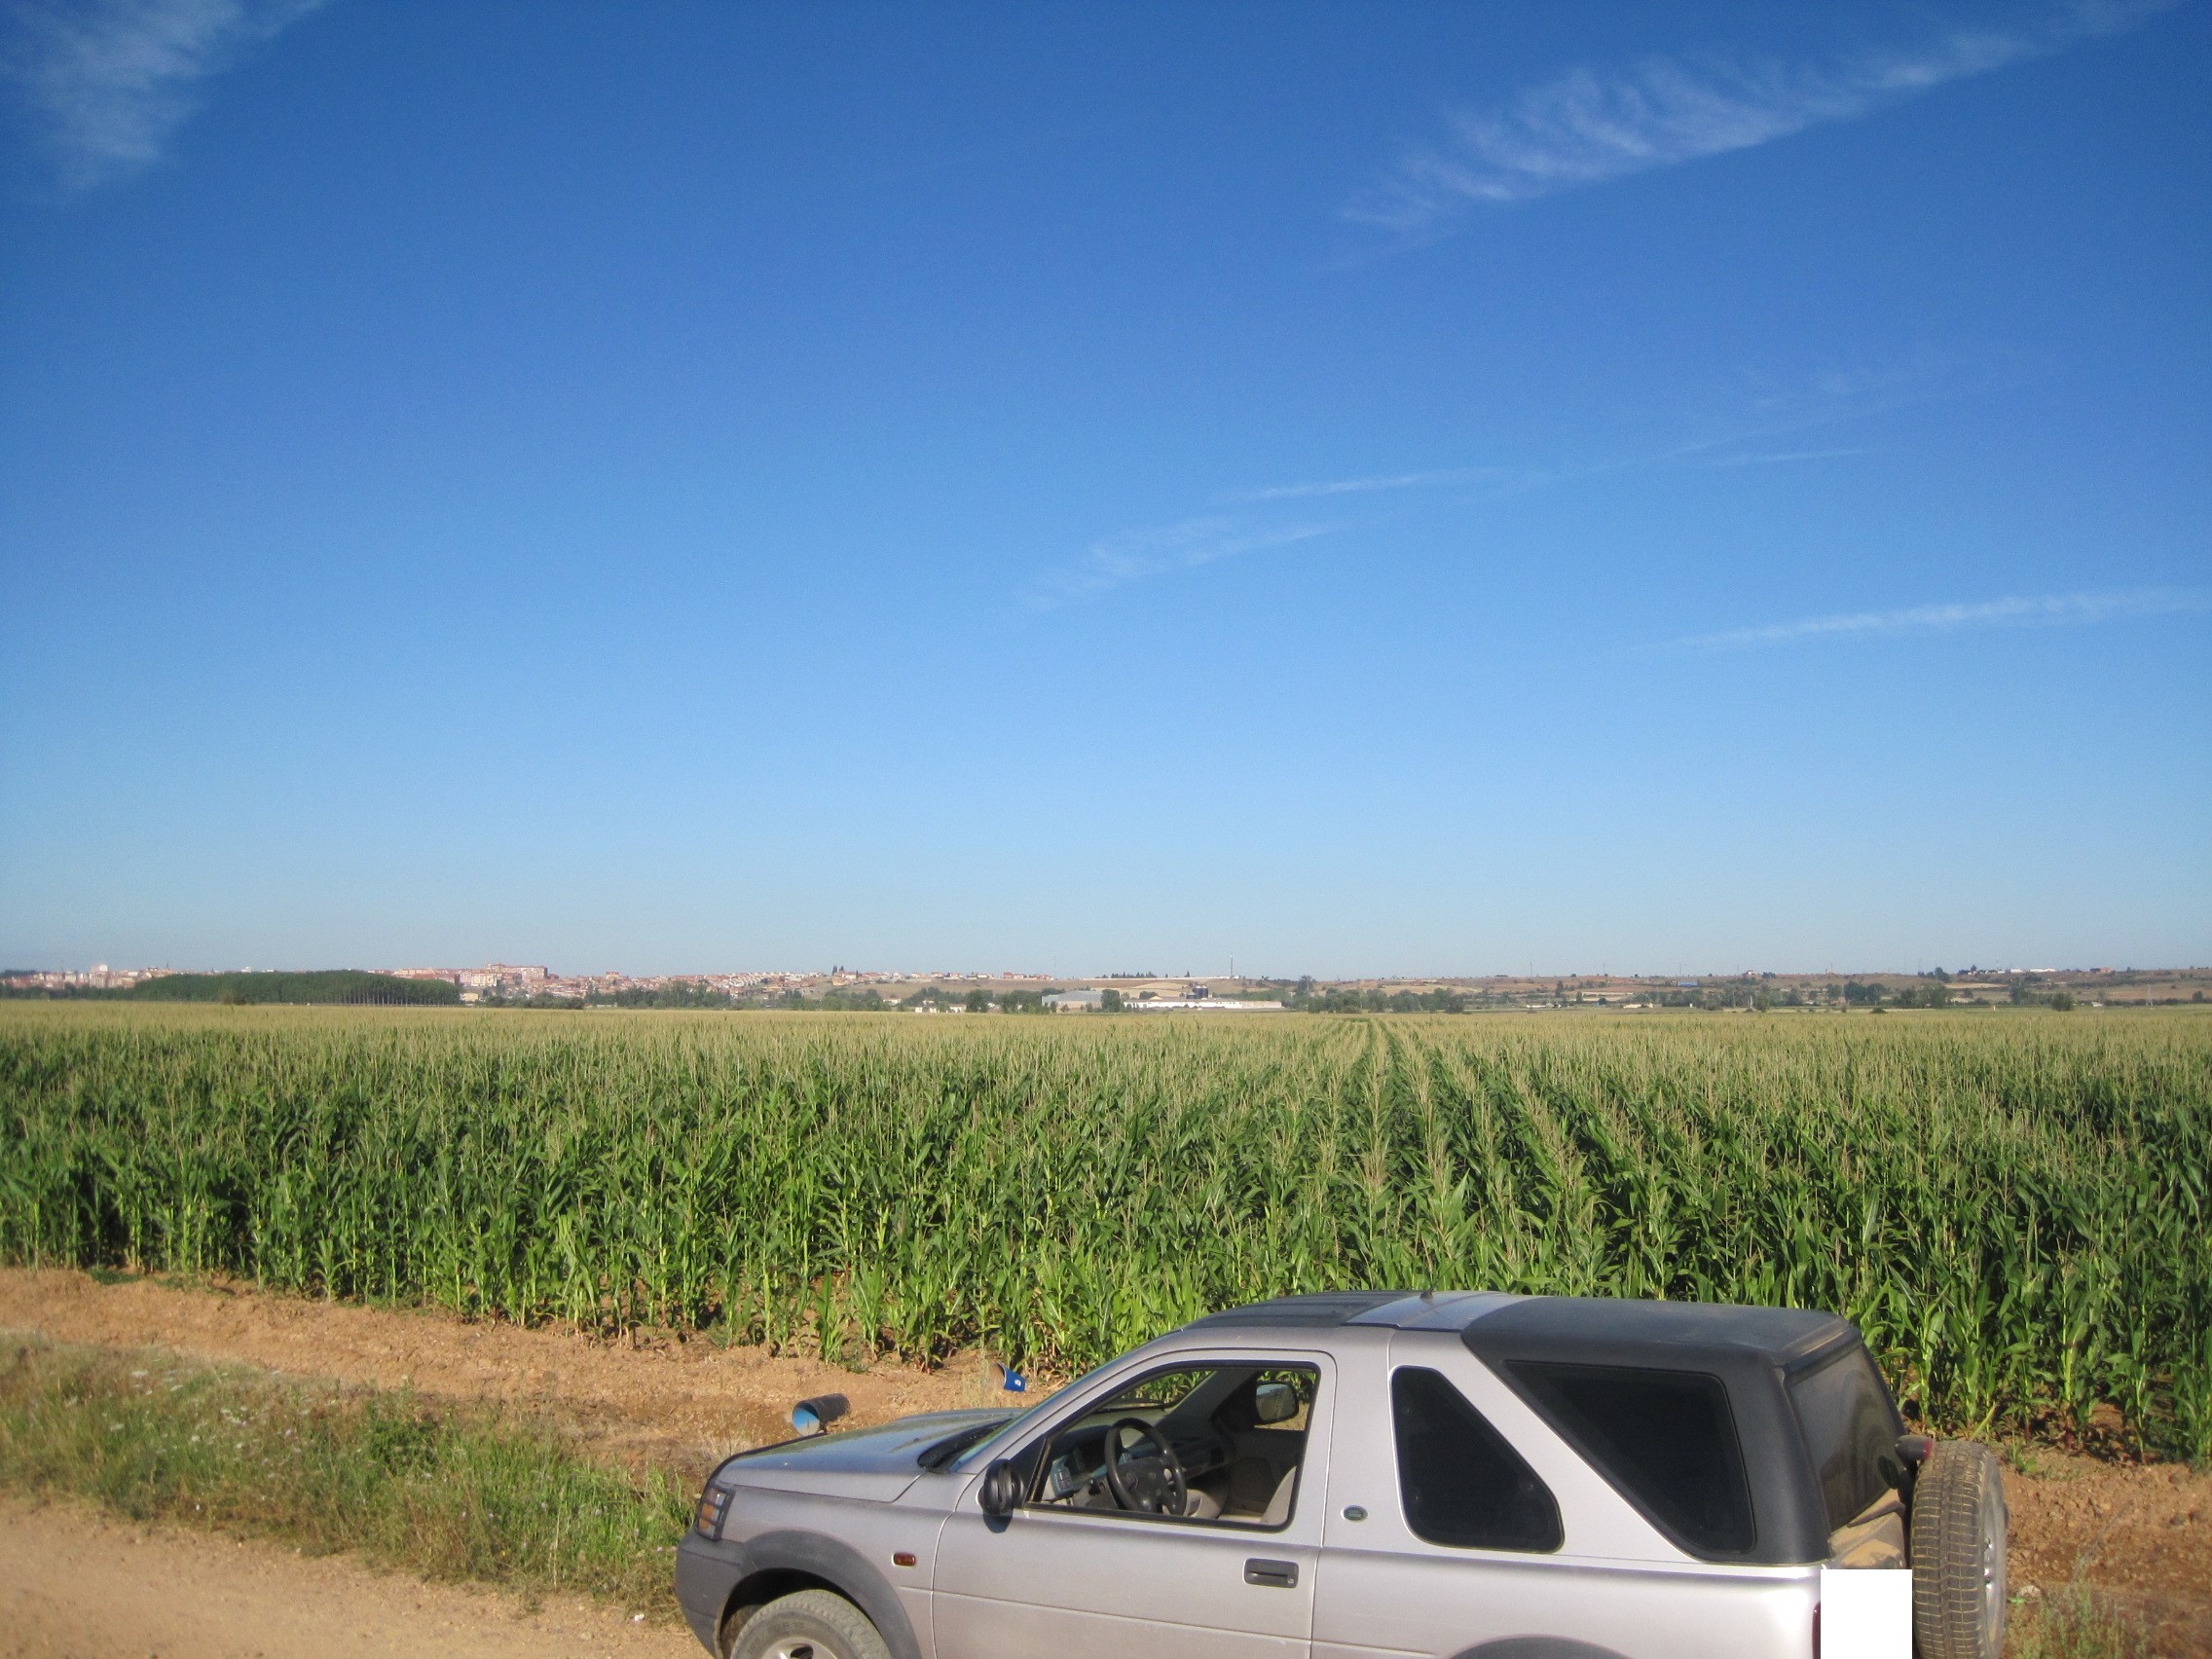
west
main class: Cropland
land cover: Maize
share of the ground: > 75 %
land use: Agriculture (excluding fallow land and kitchen gardens)
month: July
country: ES
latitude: 42.0189
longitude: -5.6334
